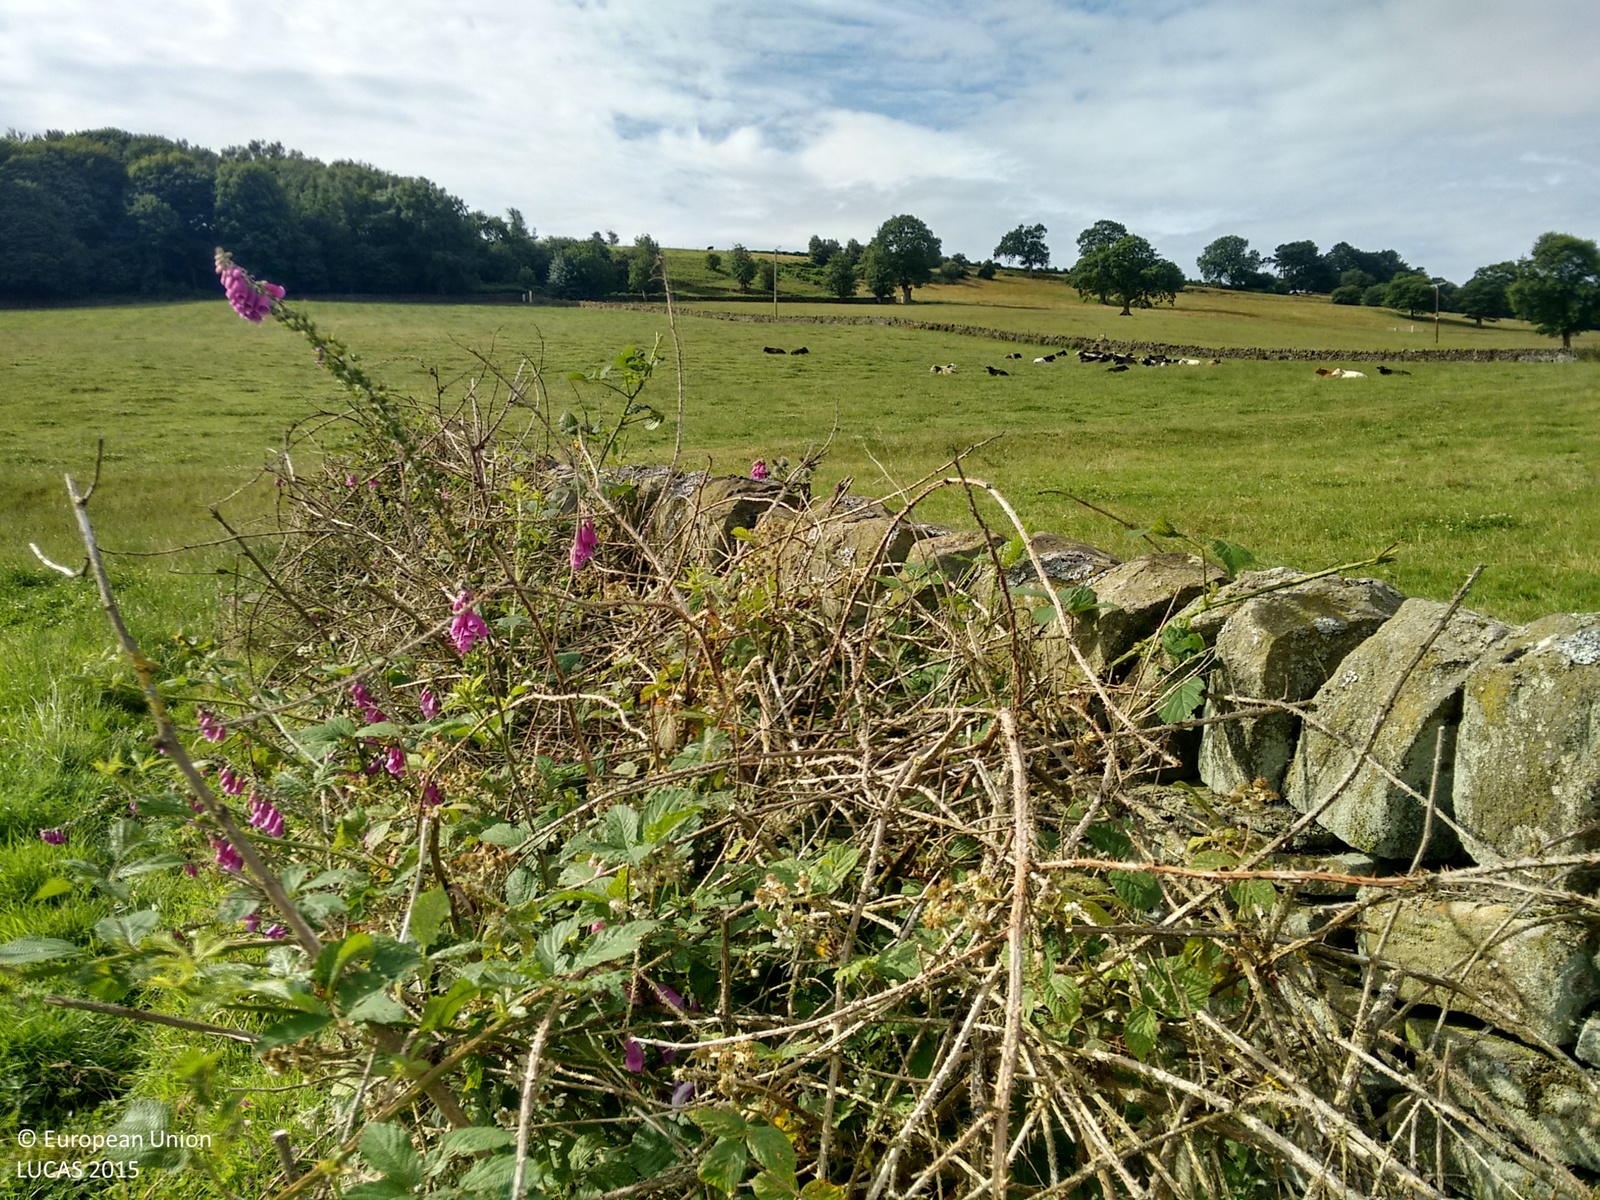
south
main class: Grassland
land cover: Grassland without tree/shrub cover
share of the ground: > 75 %
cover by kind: herbaceous plants 100 %
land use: Agriculture (excluding fallow land and kitchen gardens)
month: July
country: GB
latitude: 53.0851
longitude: -1.5321
